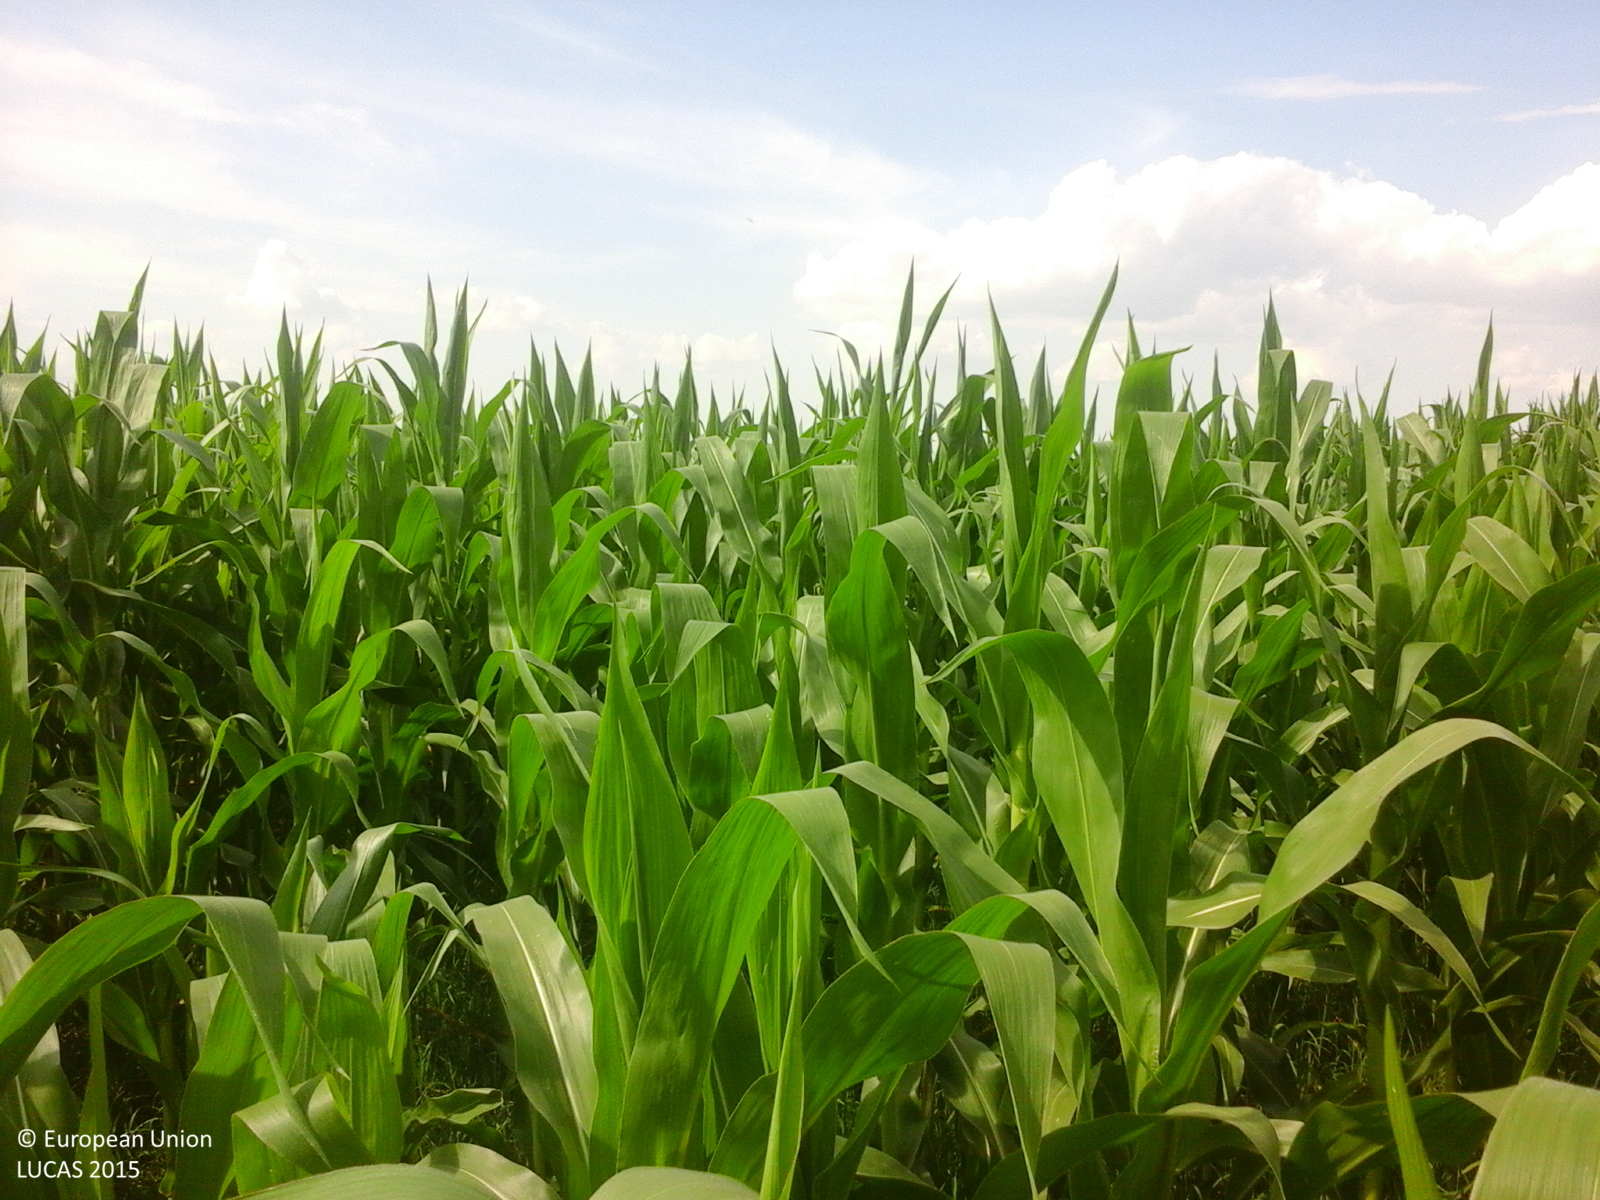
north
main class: Cropland
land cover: Maize
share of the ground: > 75 %
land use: Agriculture (excluding fallow land and kitchen gardens)
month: June
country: RO
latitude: 44.3171
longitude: 25.9609
